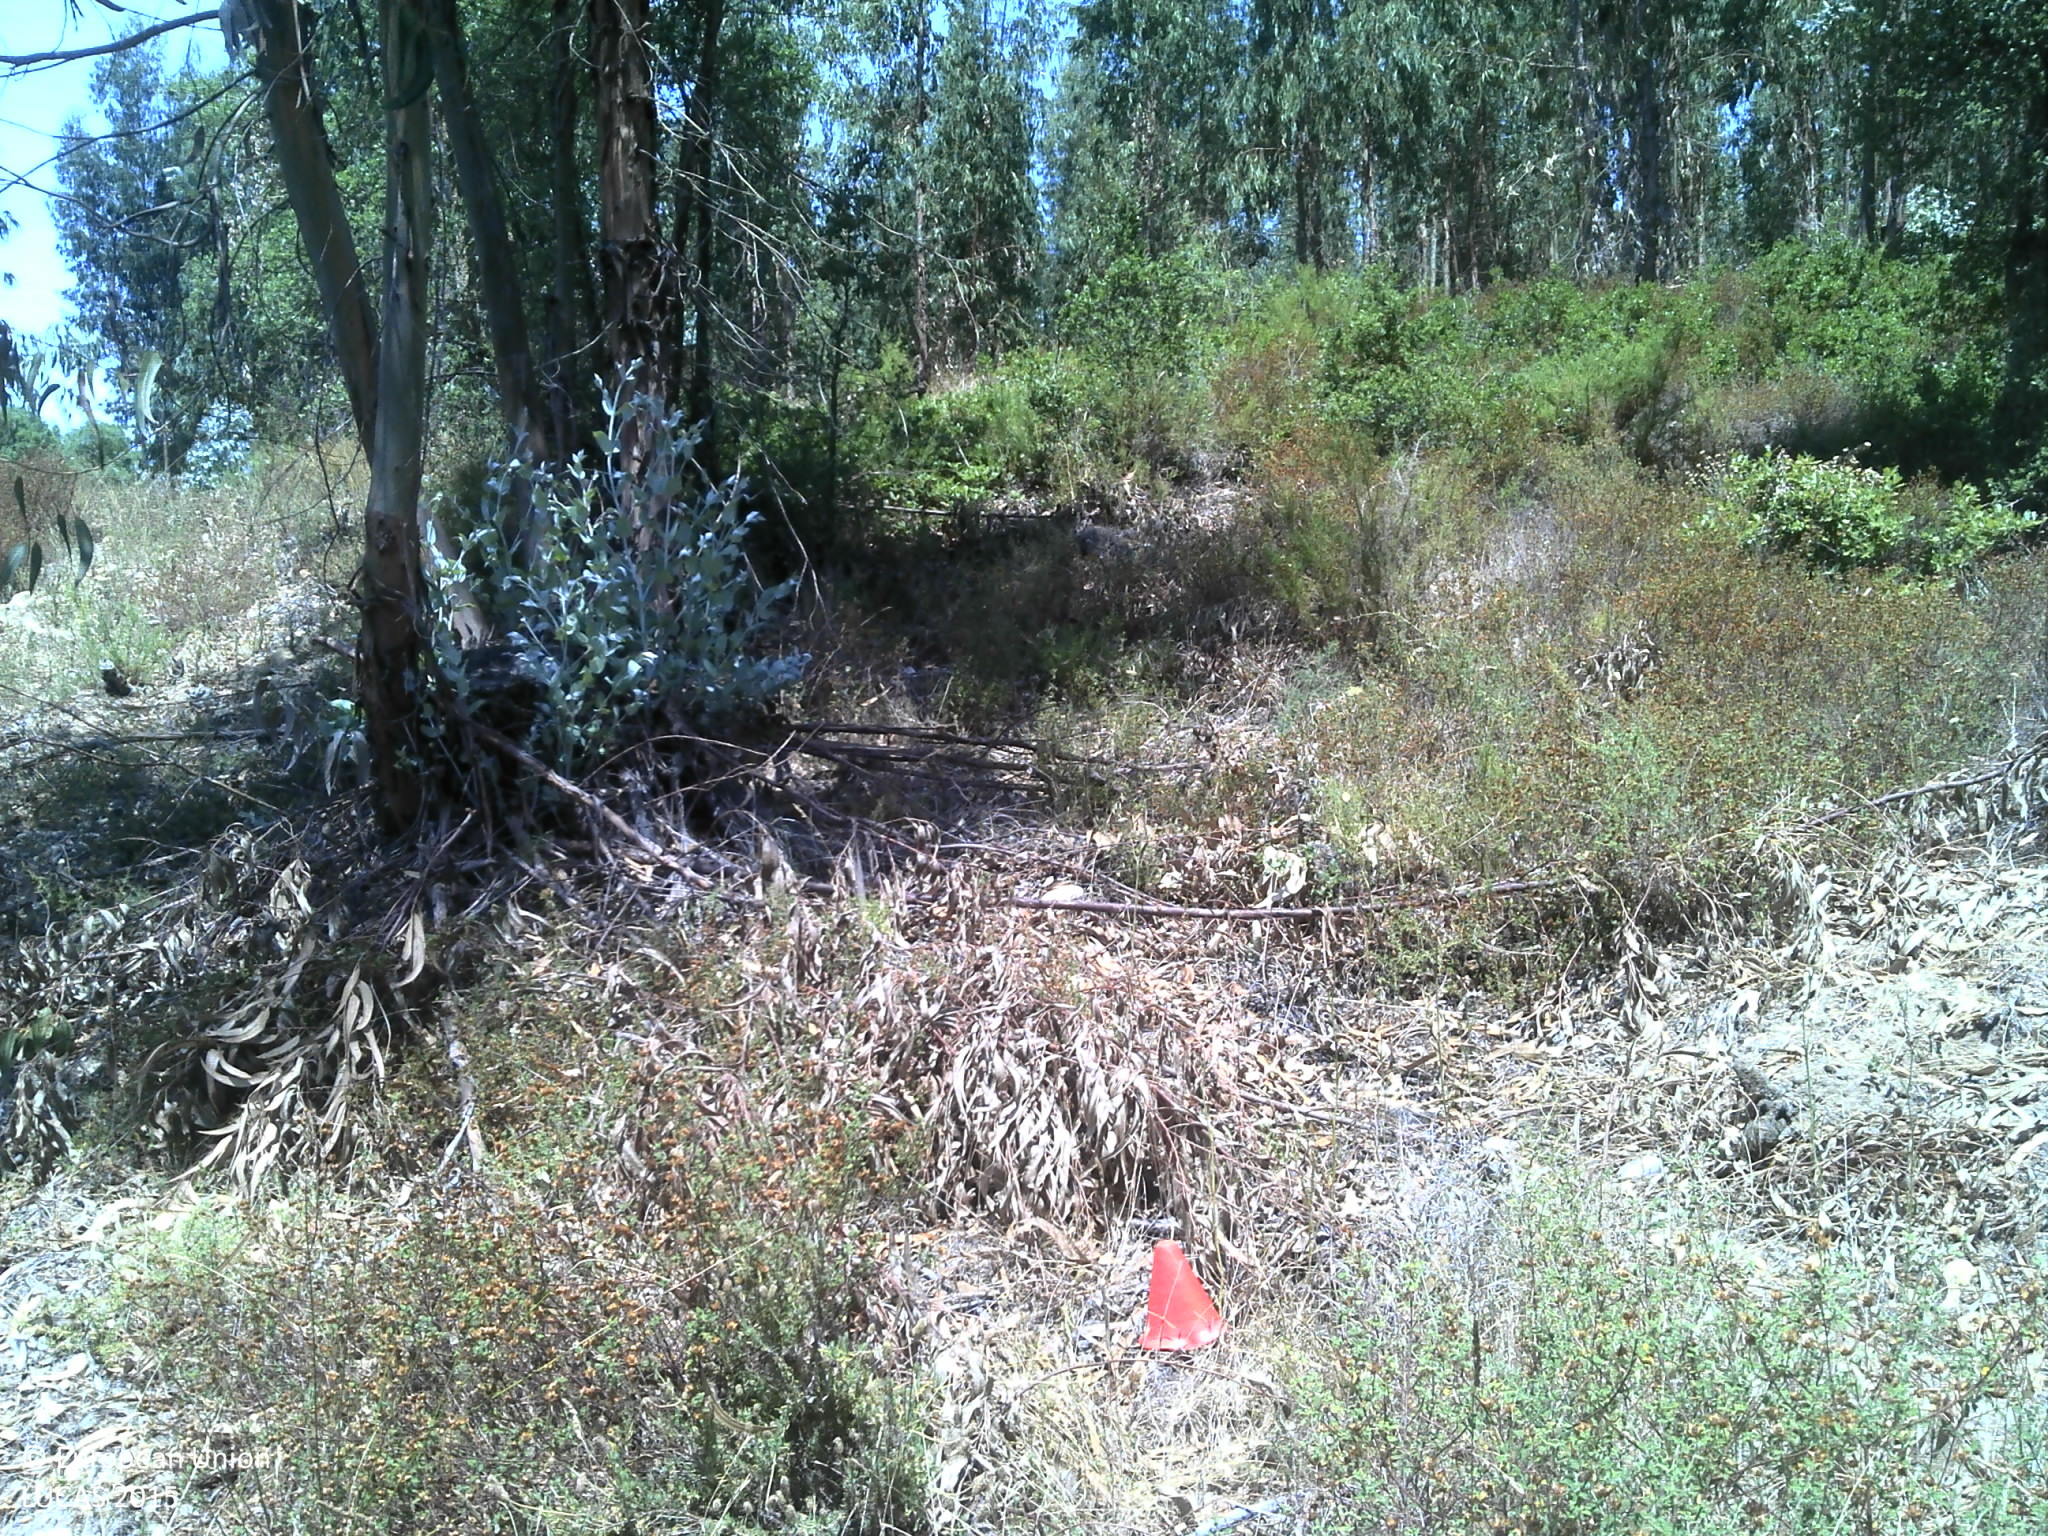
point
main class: Woodland
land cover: Broadleaved woodland
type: exotic forest
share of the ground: 25 - 50 %
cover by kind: broadleaved forest trees 45 %, unconsolidated bare surface 40 %, herbaceous plants 10 %, shrubs 5 %
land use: Forestry
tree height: > 5 m
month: July
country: PT
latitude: 39.3315
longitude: -8.2650
